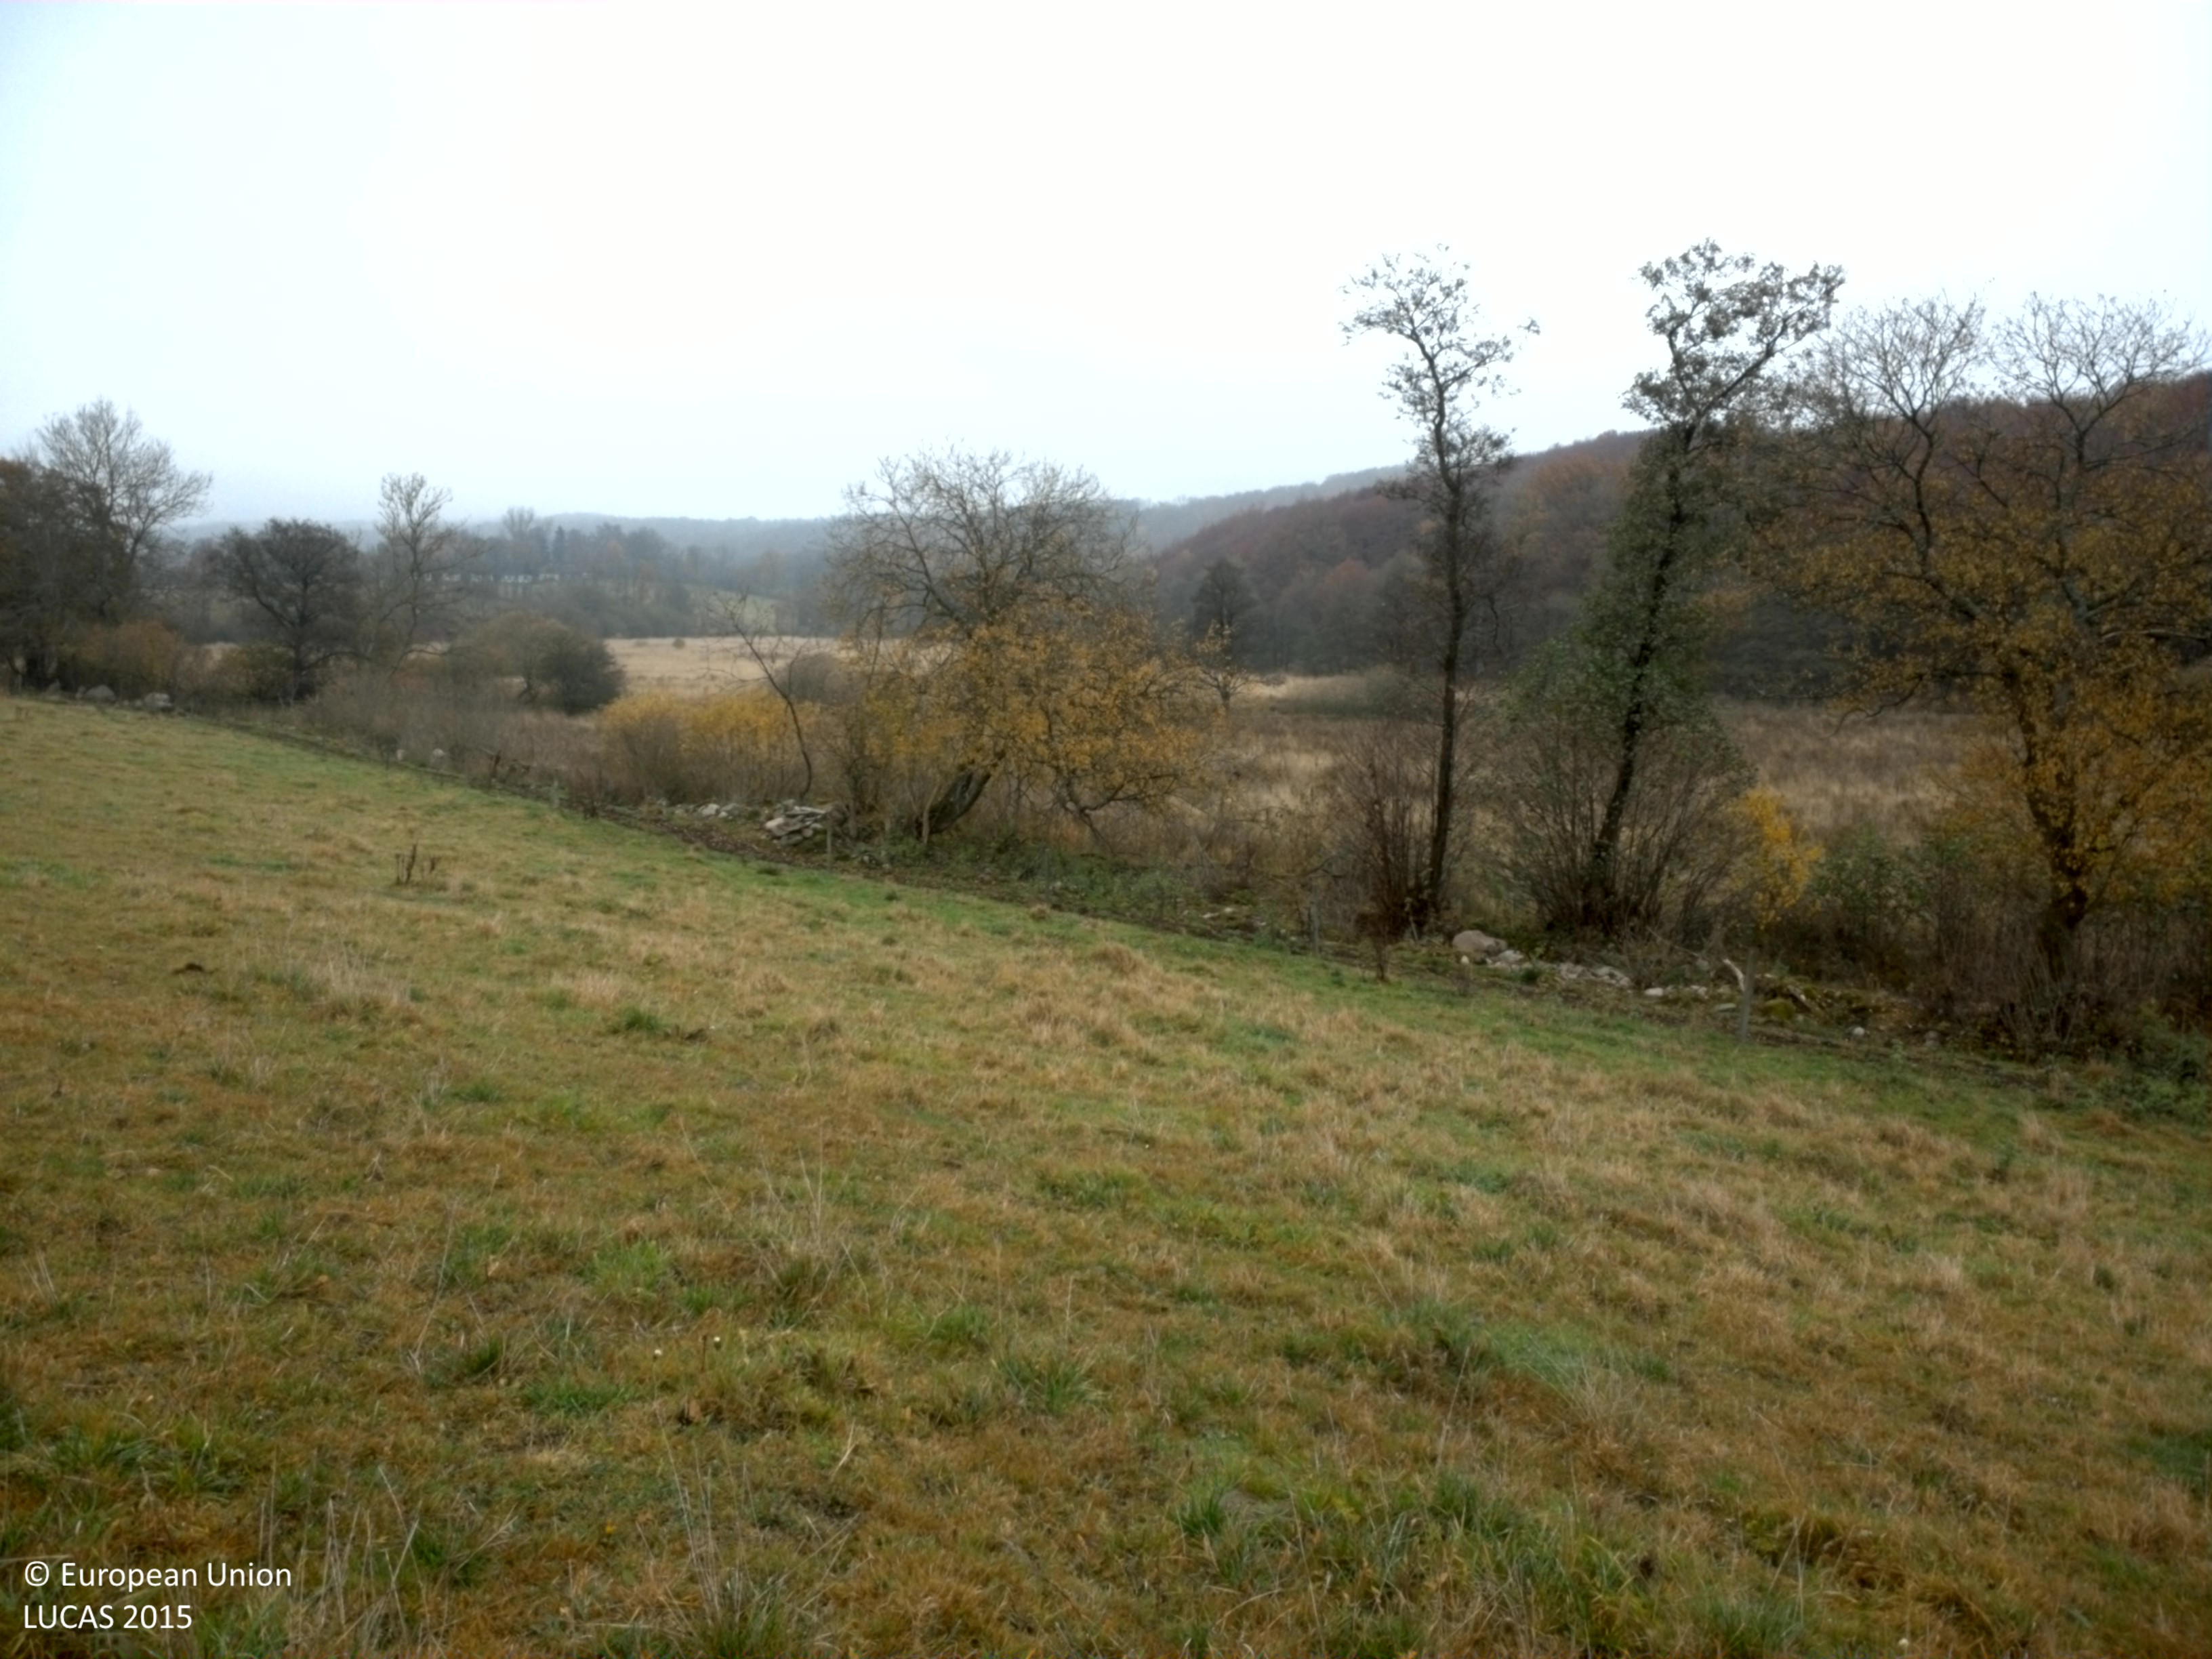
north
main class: Grassland
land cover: Grassland without tree/shrub cover
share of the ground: > 75 %
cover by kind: herbaceous plants 100 %
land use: Agriculture (excluding fallow land and kitchen gardens)
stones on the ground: < 10 %
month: November
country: SE
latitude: 56.0433
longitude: 13.0636
